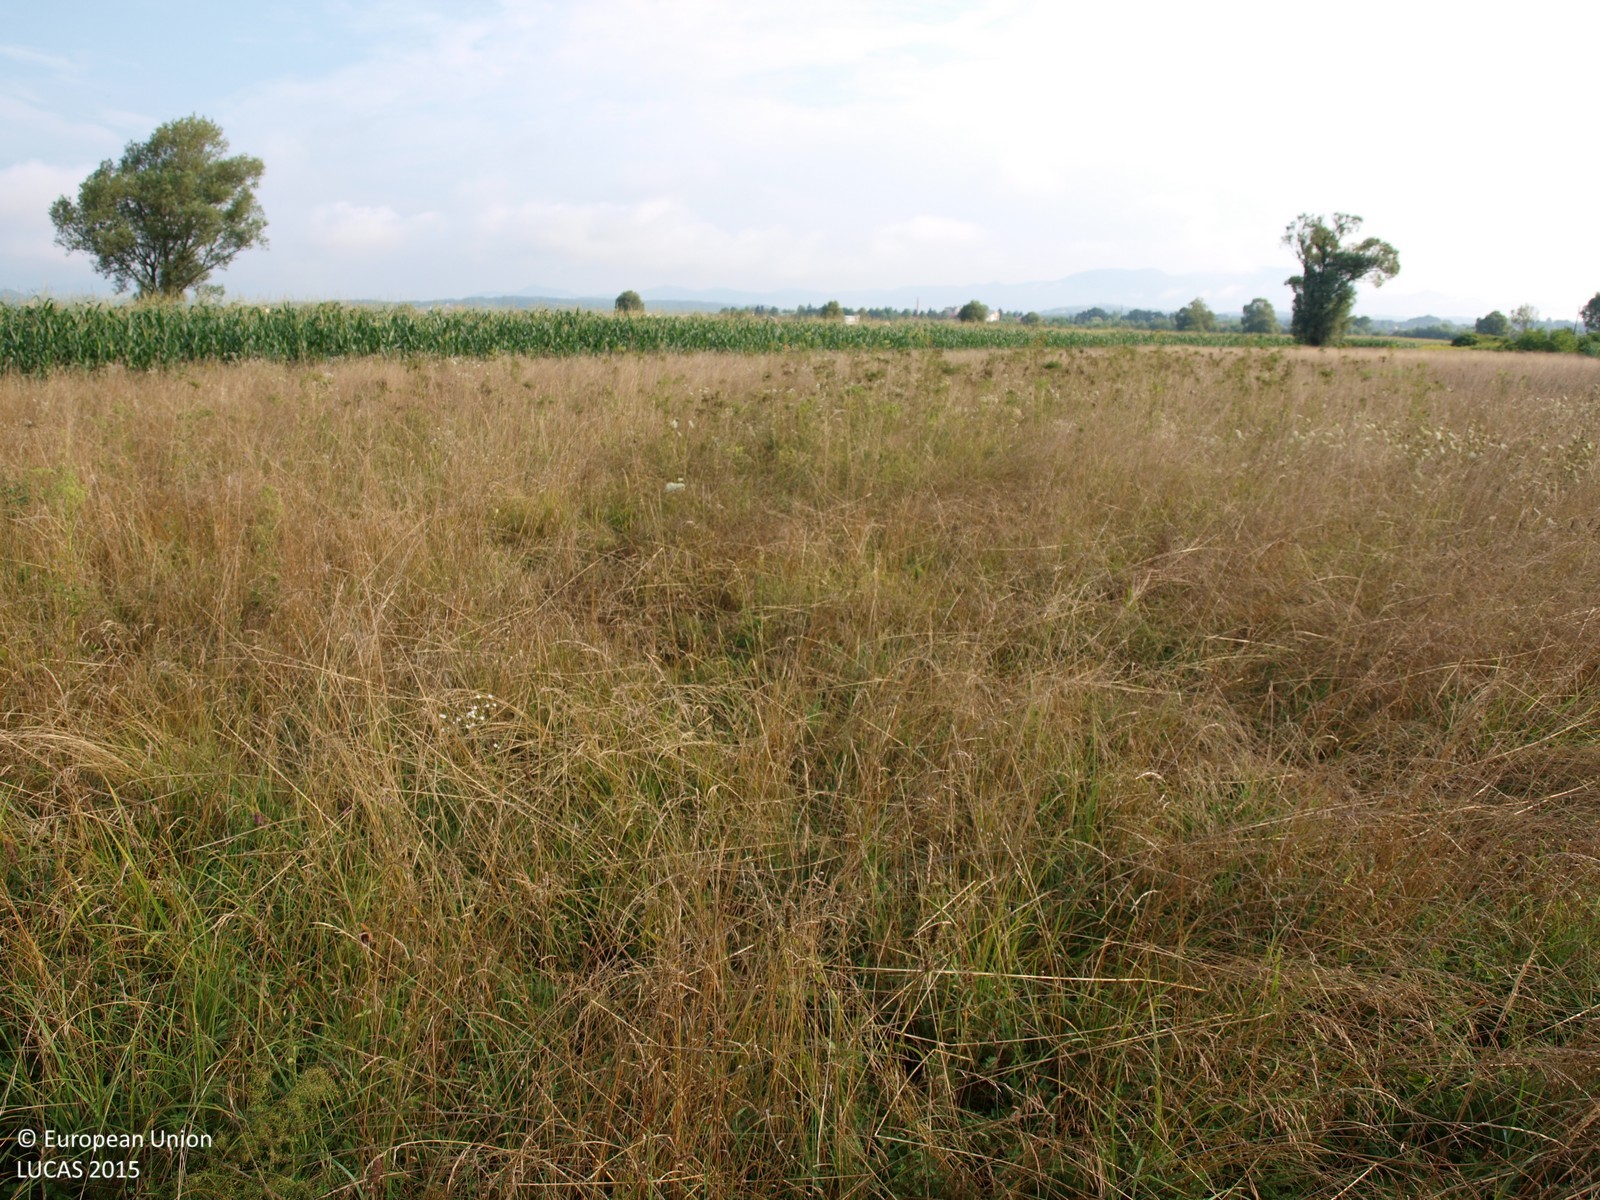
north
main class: Grassland
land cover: Grassland without tree/shrub cover
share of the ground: > 75 %
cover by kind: herbaceous plants 100 %
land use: Agriculture (excluding fallow land and kitchen gardens)
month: July
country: HR
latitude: 46.0335
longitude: 16.0842
